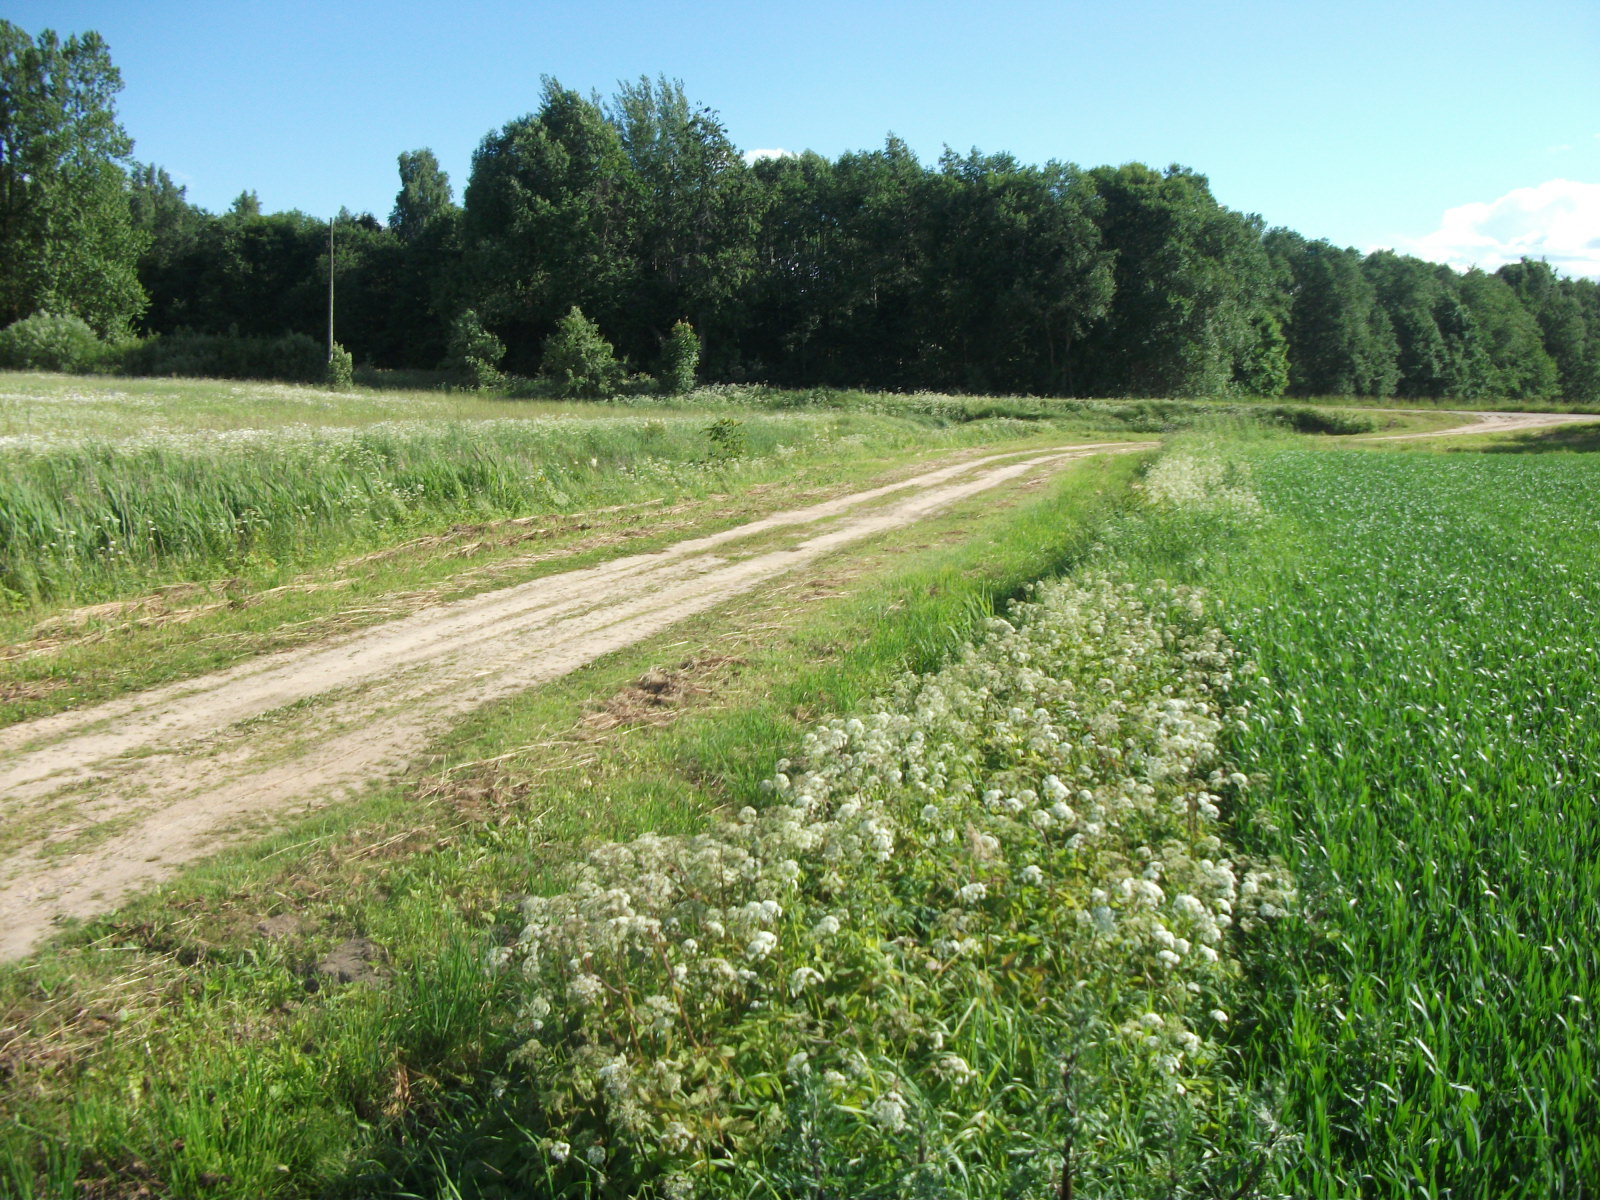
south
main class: Cropland
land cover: Common wheat
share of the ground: > 75 %
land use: Agriculture (excluding fallow land and kitchen gardens)
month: June
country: LV
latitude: 57.0100
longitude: 26.5989
